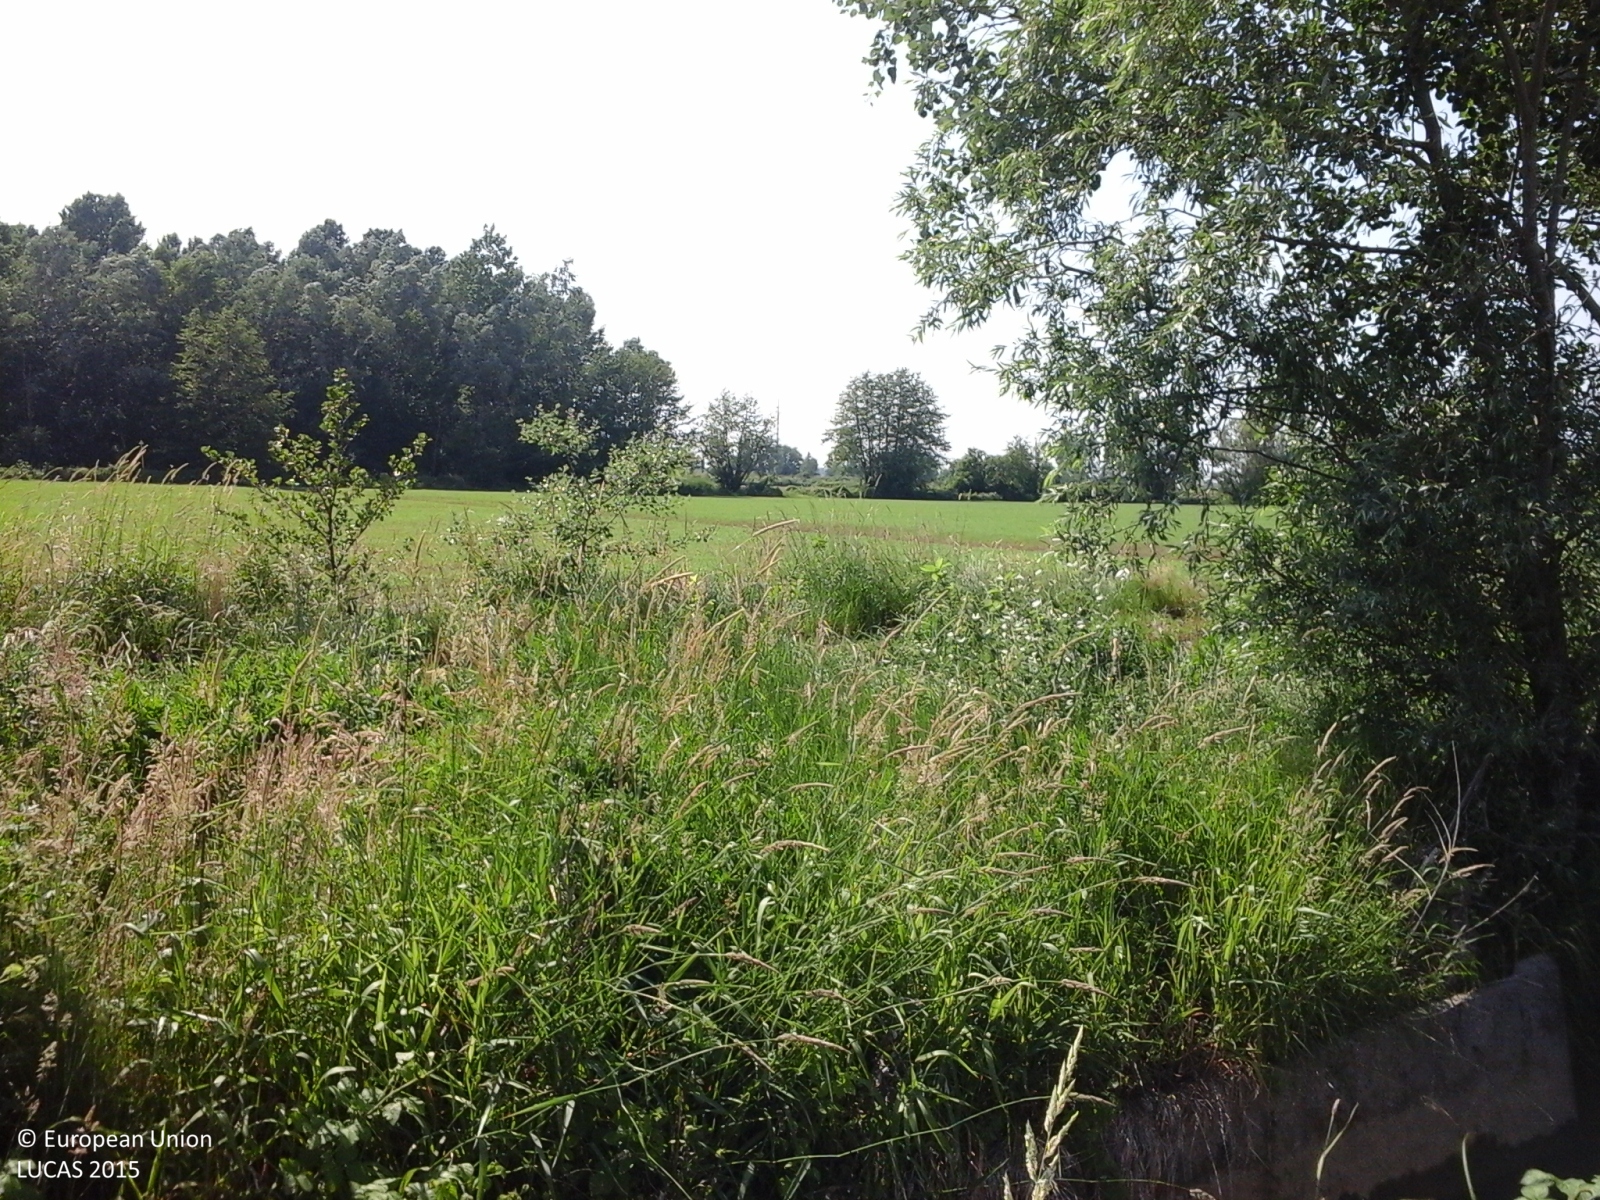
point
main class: Cropland
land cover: Rice
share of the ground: 50 - 75 %
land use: Agriculture (excluding fallow land and kitchen gardens)
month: May
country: IT
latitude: 45.3023
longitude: 9.0962
